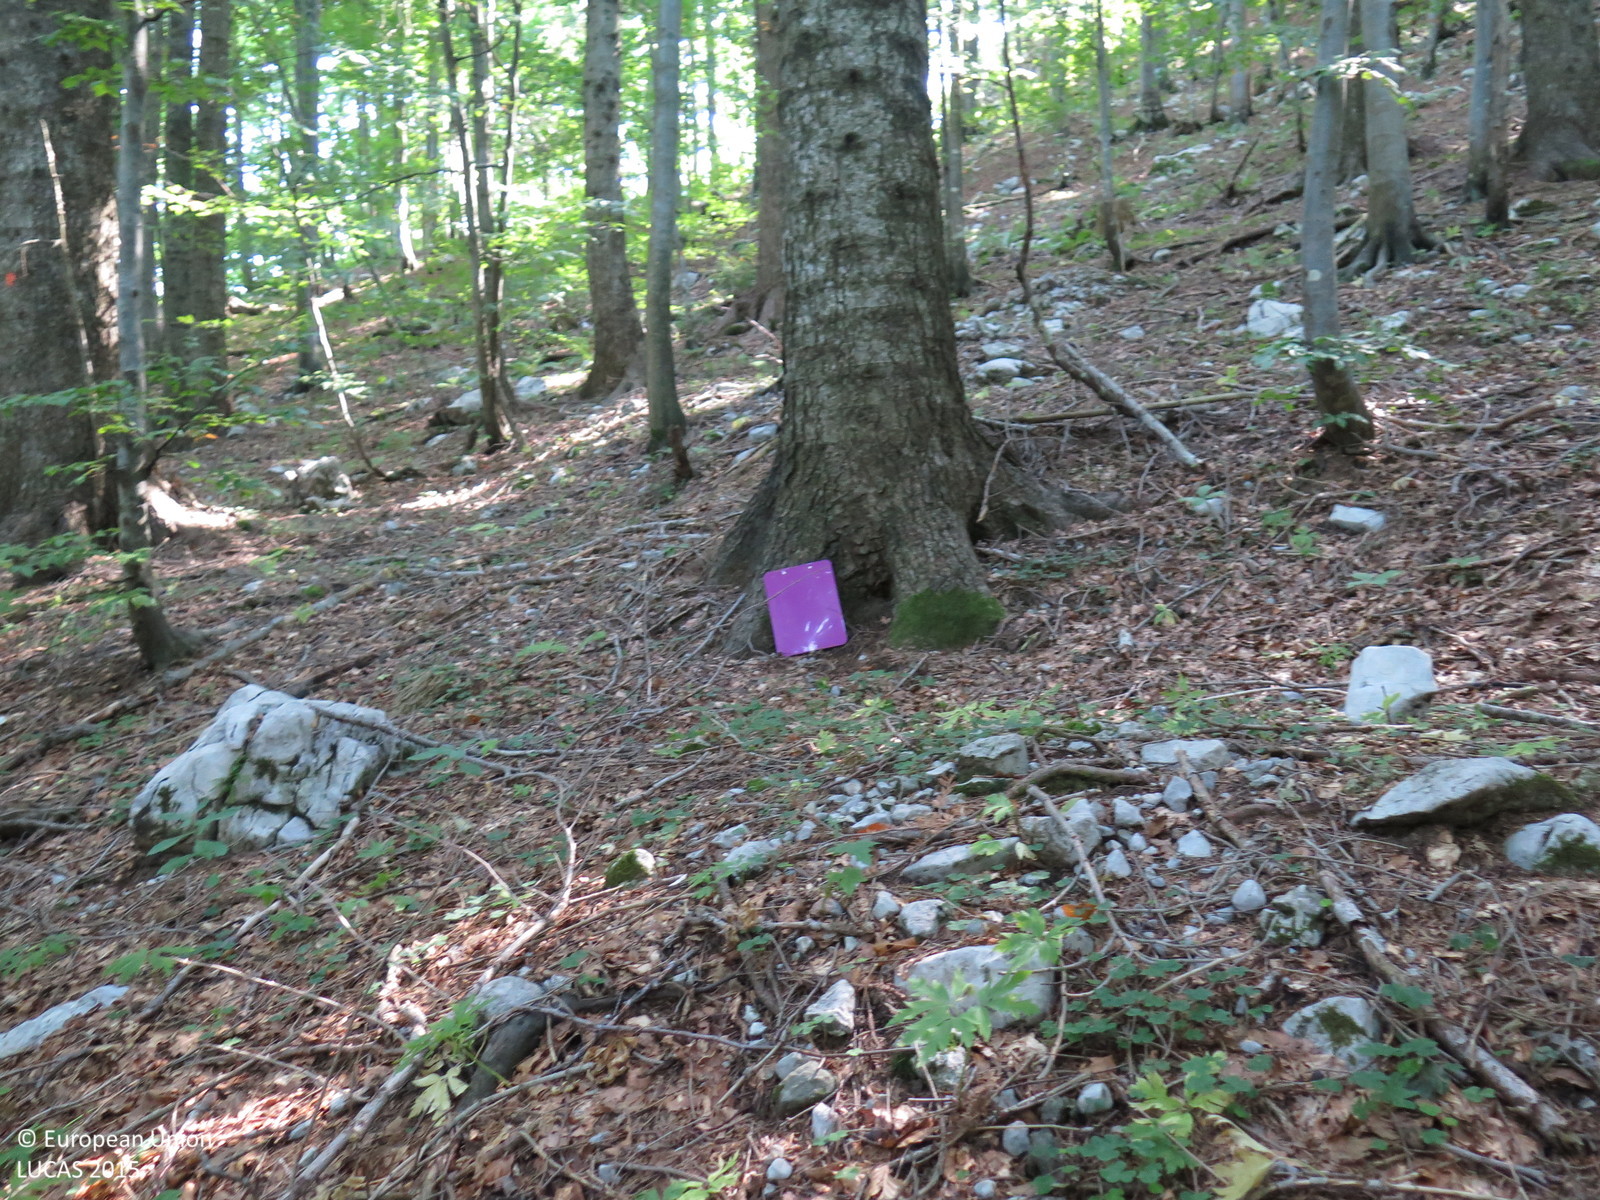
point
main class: Woodland
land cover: Other mixed woodland
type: mountainous beech forest
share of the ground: > 75 %
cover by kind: broadleaved forest trees 75 %, coniferous forest trees 25 %
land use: Forestry
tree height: > 5 m
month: September
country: HR
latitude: 45.5352
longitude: 14.4902
